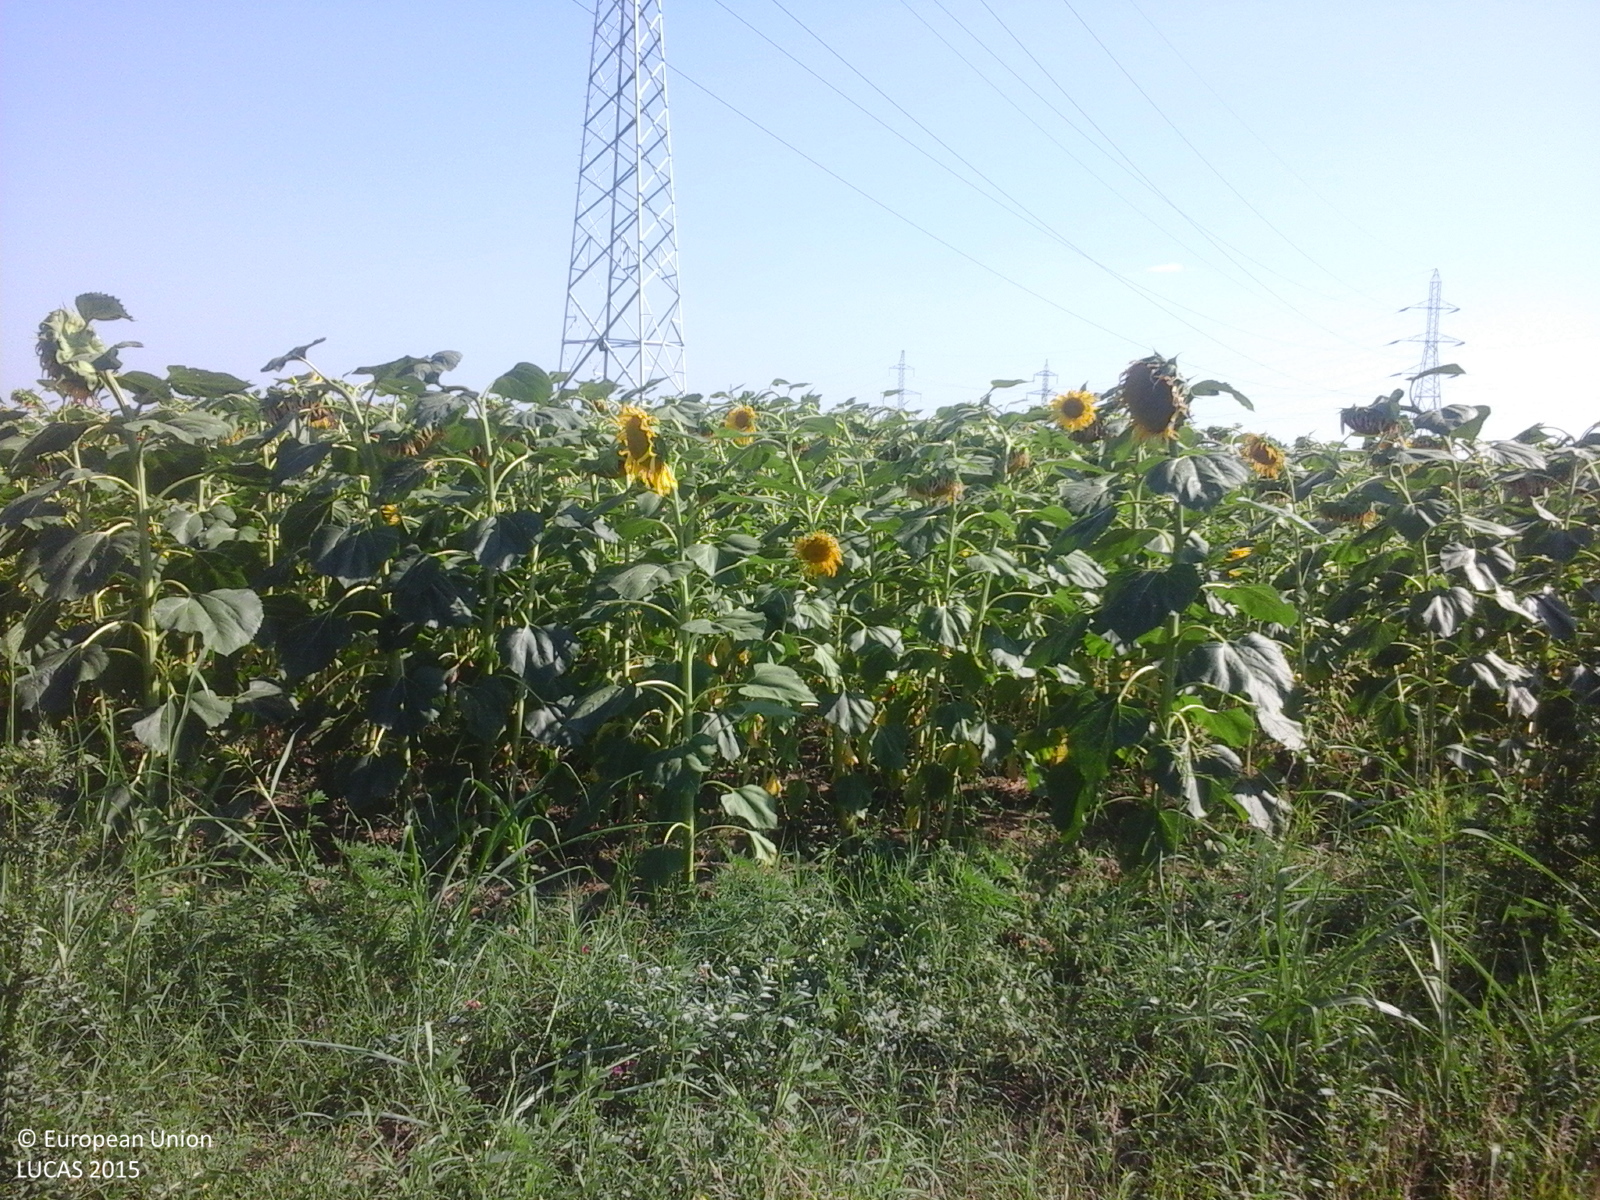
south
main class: Cropland
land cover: Sunflower
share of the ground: > 75 %
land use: Agriculture (excluding fallow land and kitchen gardens)
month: July
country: RO
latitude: 44.1986
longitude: 27.3656
